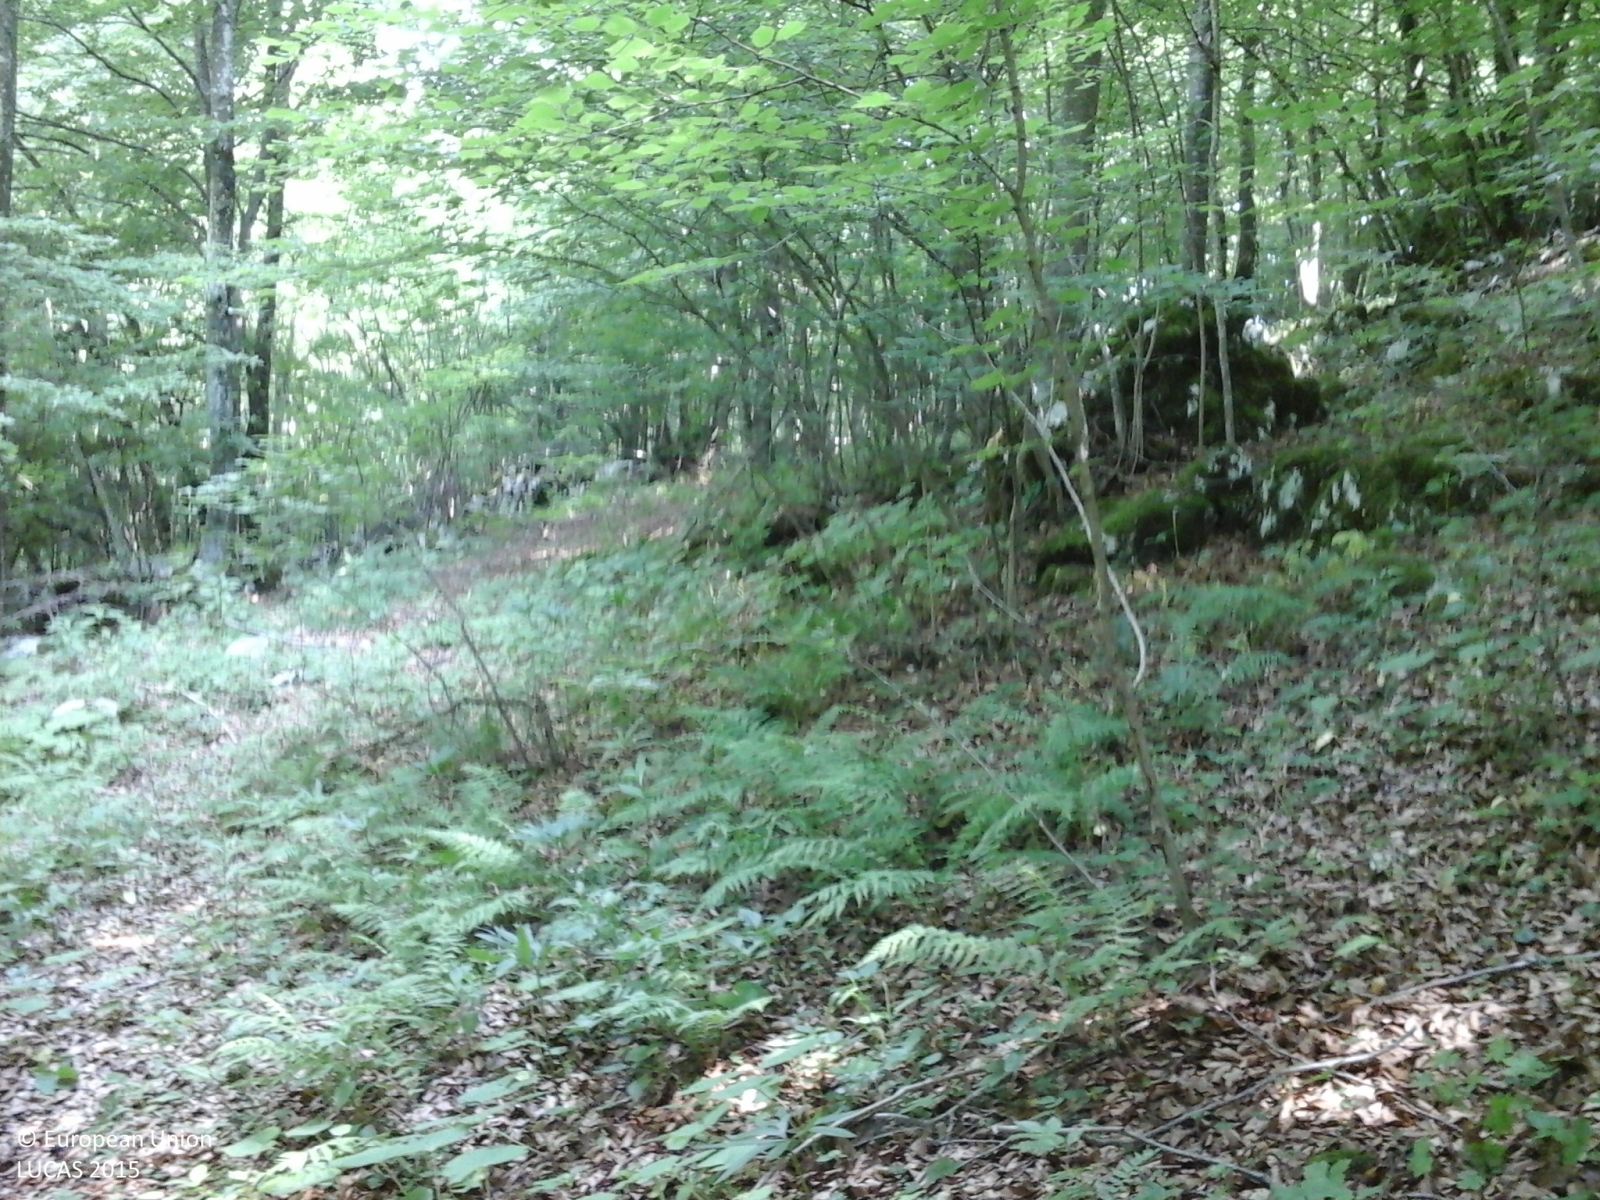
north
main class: Woodland
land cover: Broadleaved woodland
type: mountainous beech forest
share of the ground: > 75 %
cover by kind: broadleaved forest trees 100 %
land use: Forestry
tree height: > 5 m
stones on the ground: 25 - 50 %
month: June
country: IT
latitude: 45.8158
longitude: 11.6577
